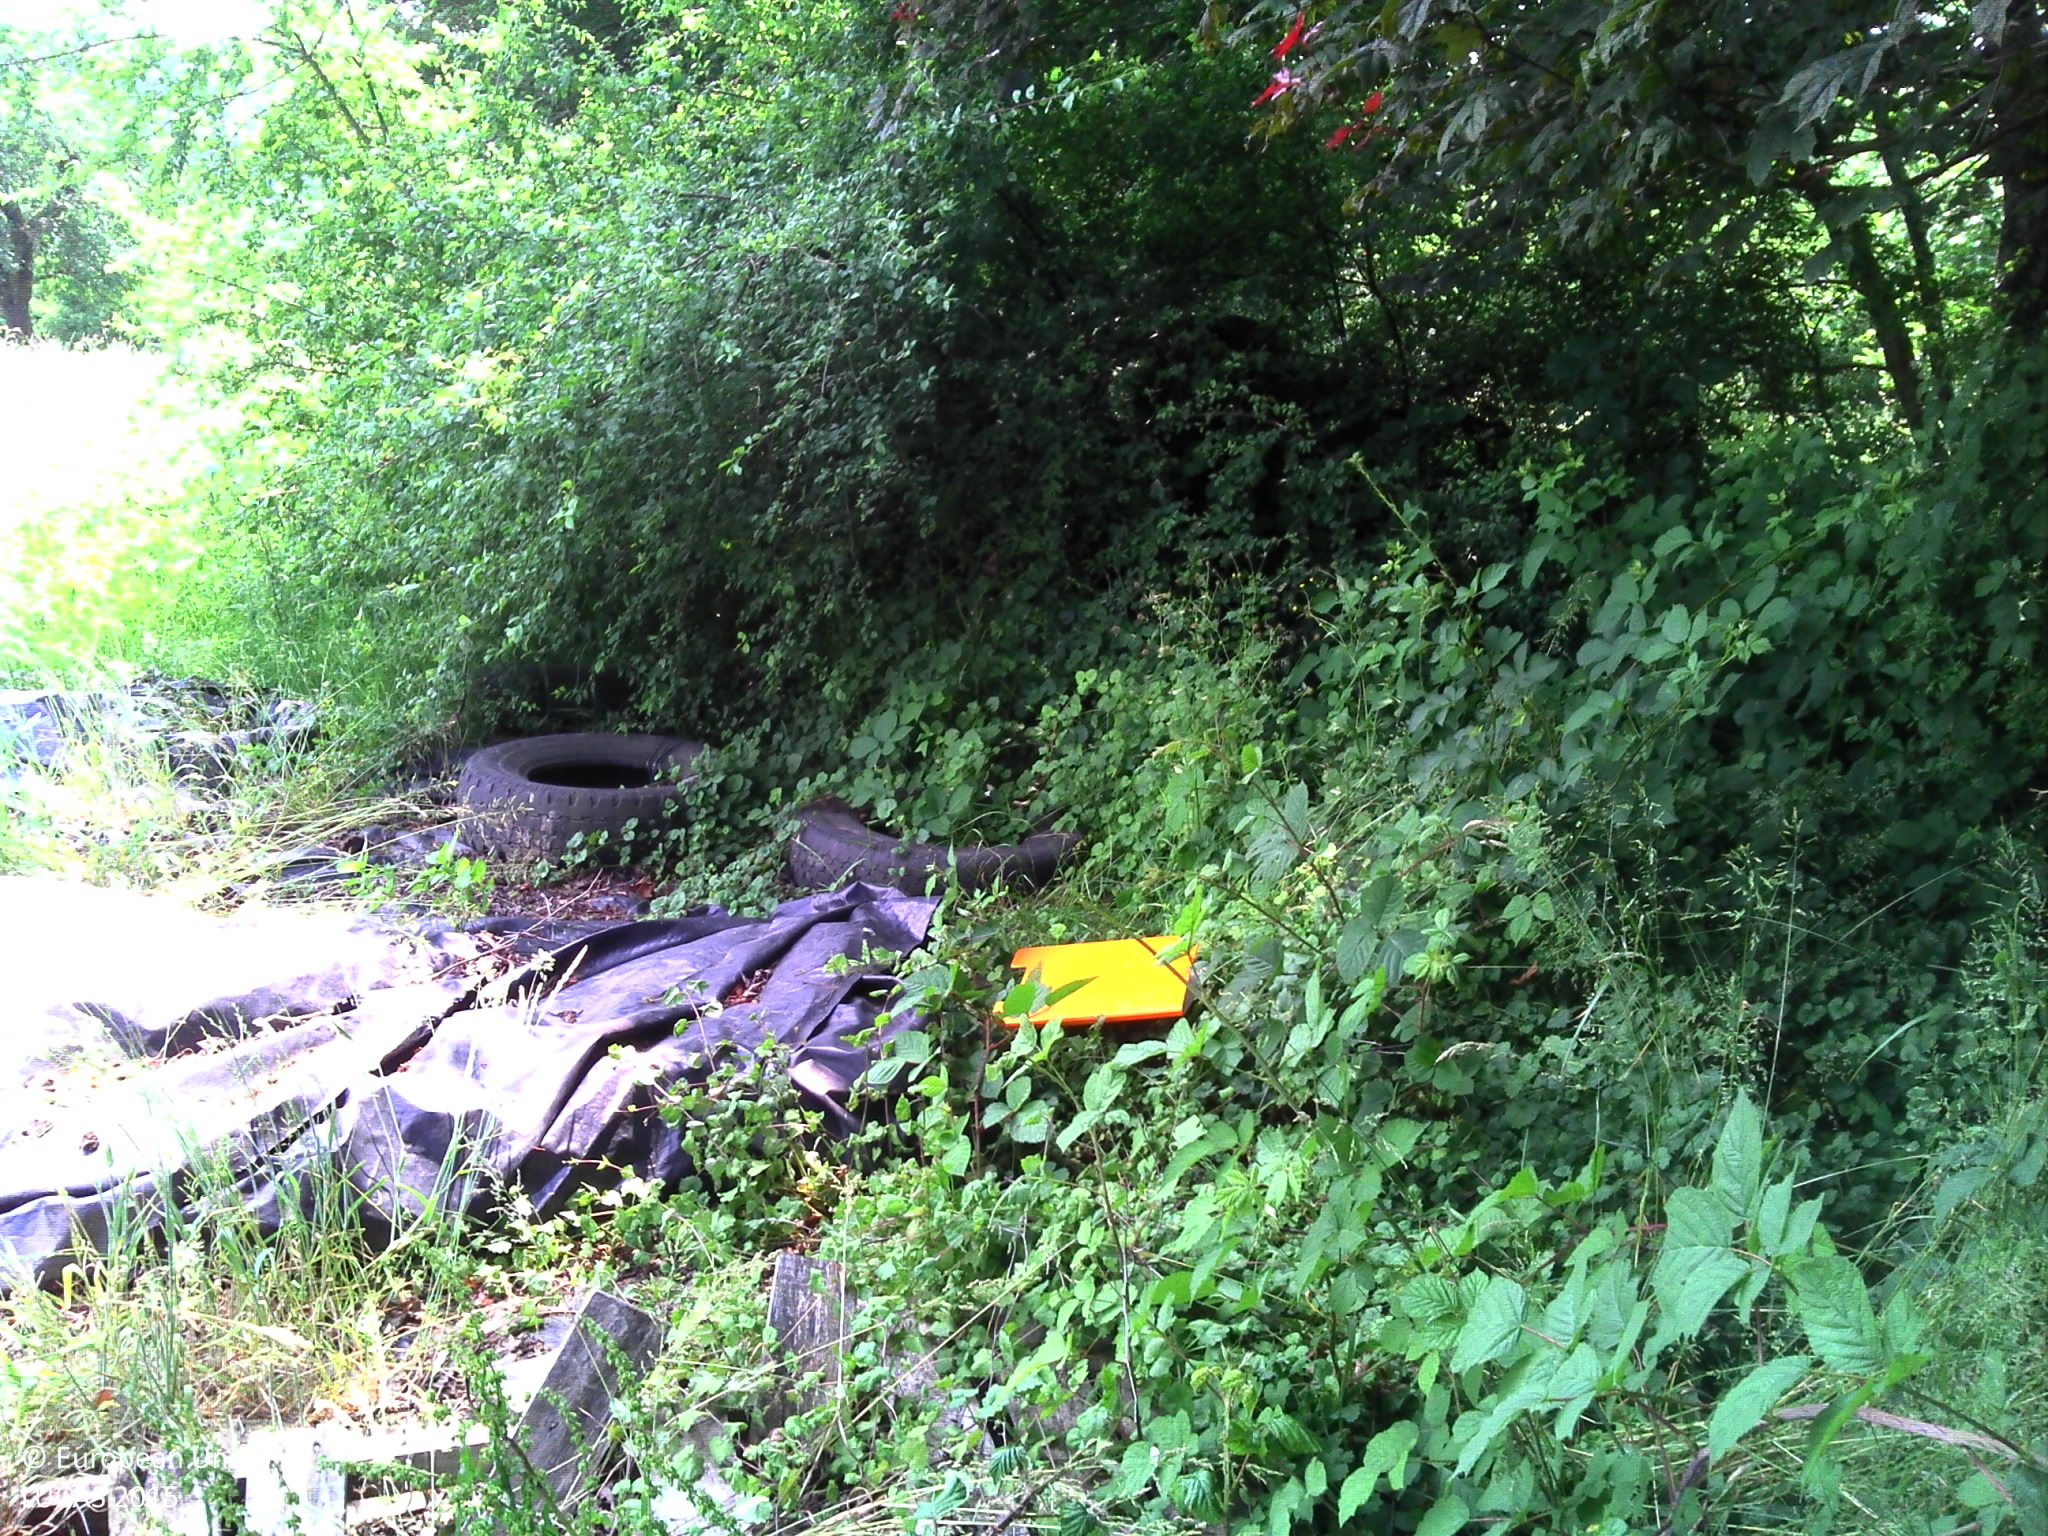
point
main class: Grassland
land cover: Grassland without tree/shrub cover
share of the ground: > 75 %
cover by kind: herbaceous plants 100 %
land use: Agriculture (excluding fallow land and kitchen gardens)
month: June
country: FR
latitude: 47.8372
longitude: 6.3001
